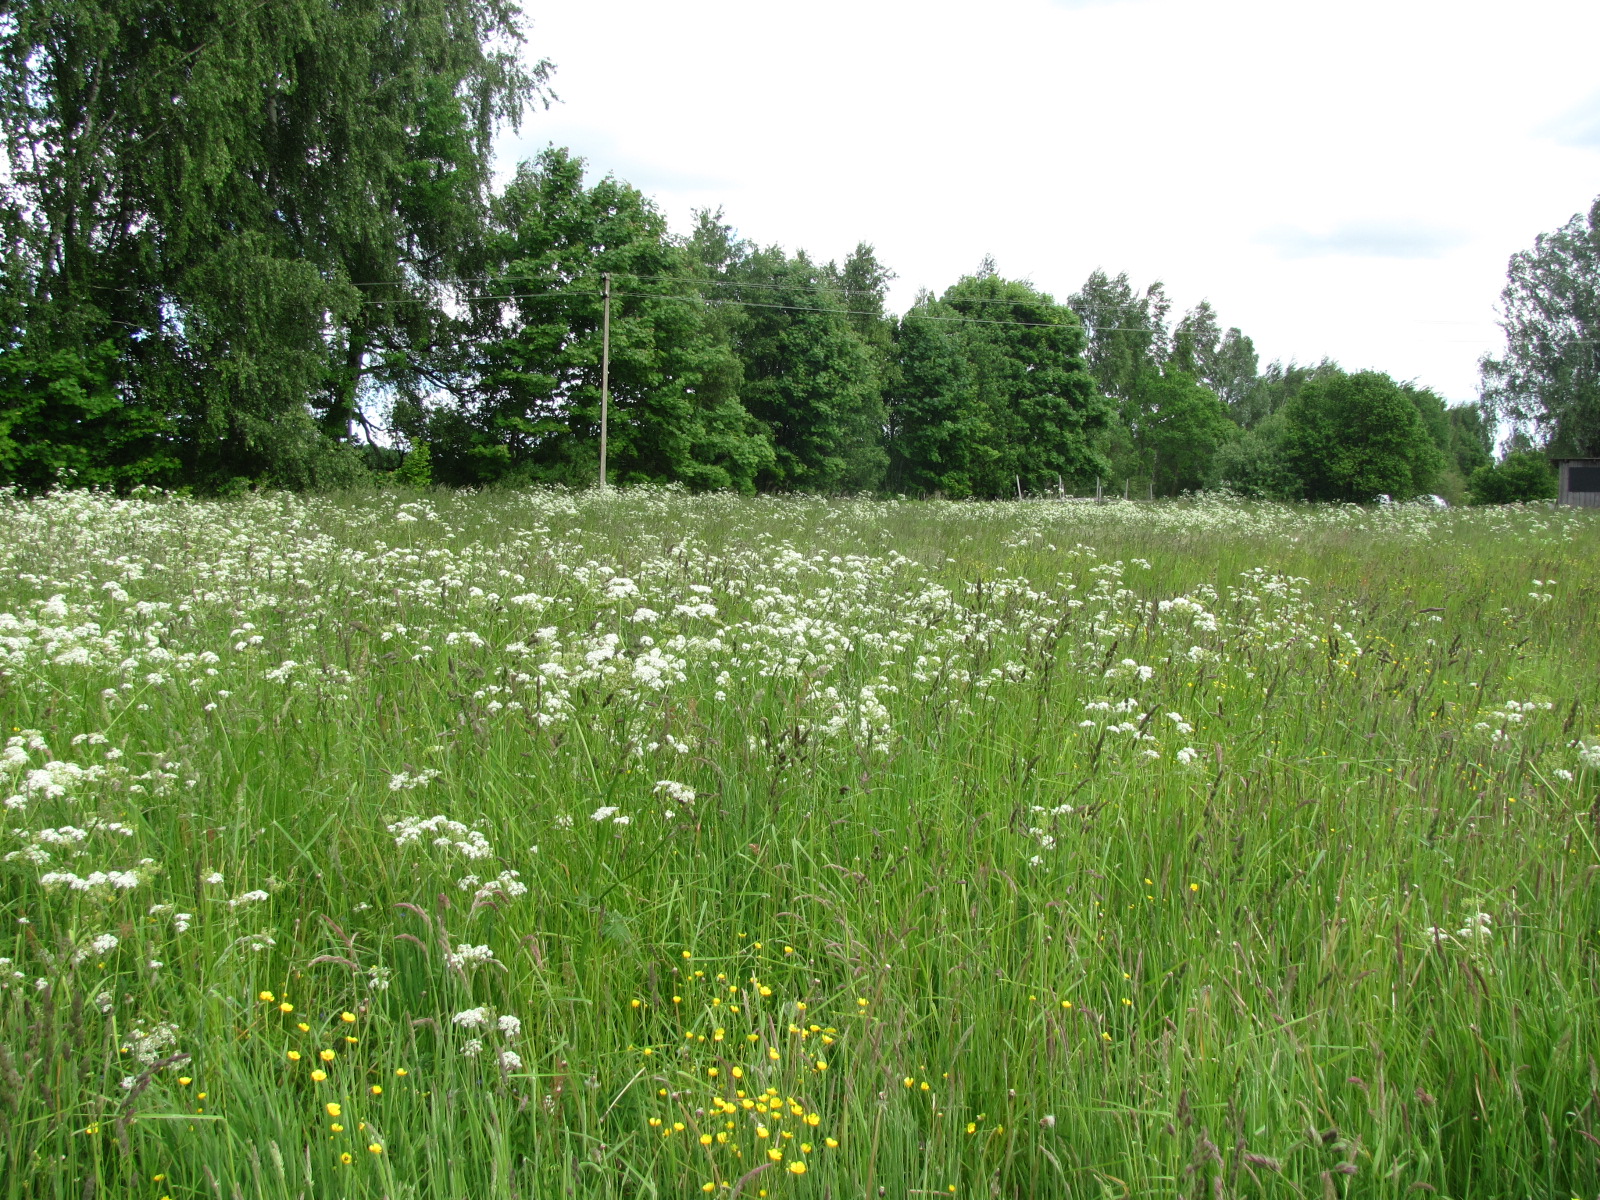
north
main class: Grassland
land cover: Grassland without tree/shrub cover
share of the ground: > 75 %
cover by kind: herbaceous plants 100 %
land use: Agriculture (excluding fallow land and kitchen gardens)
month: June
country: LV
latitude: 56.6757
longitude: 23.8396
